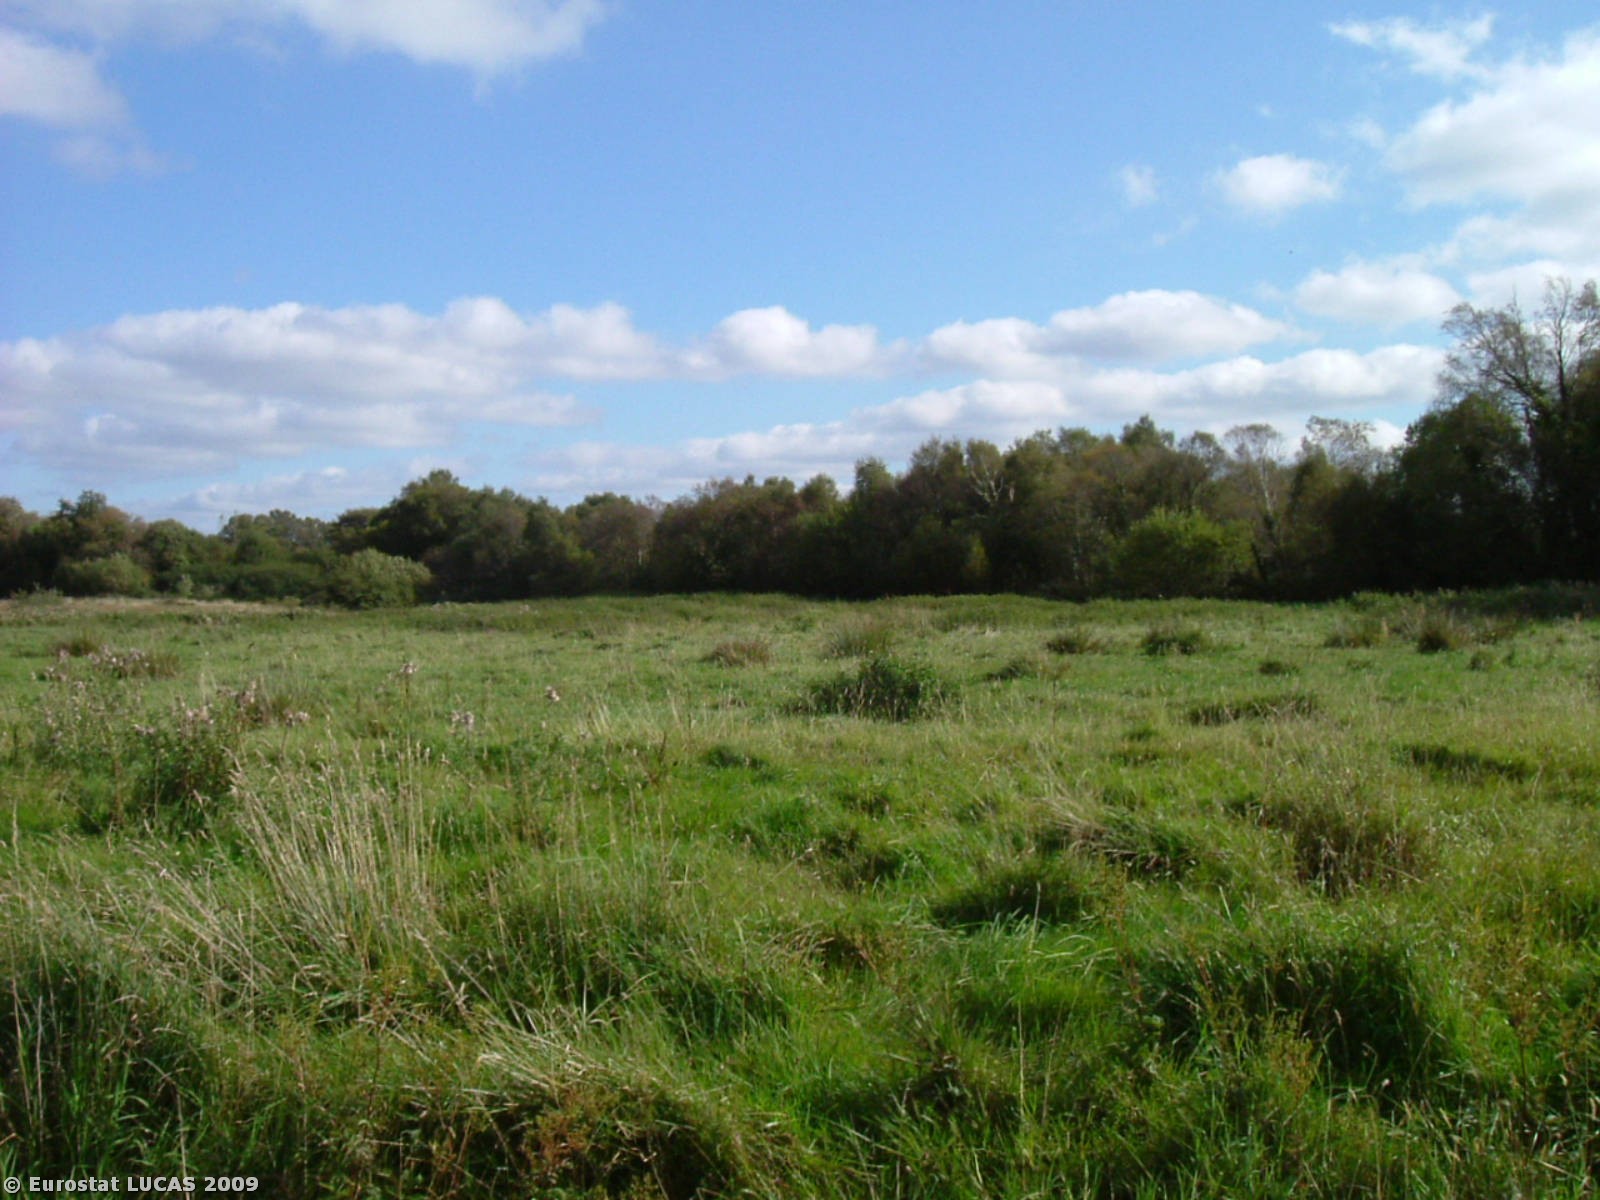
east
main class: Wetlands
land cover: Peatbogs
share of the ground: > 75 %
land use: Mining and quarrying
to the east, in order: Peatbogs
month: September
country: IE
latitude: 52.8126
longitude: -7.7482
